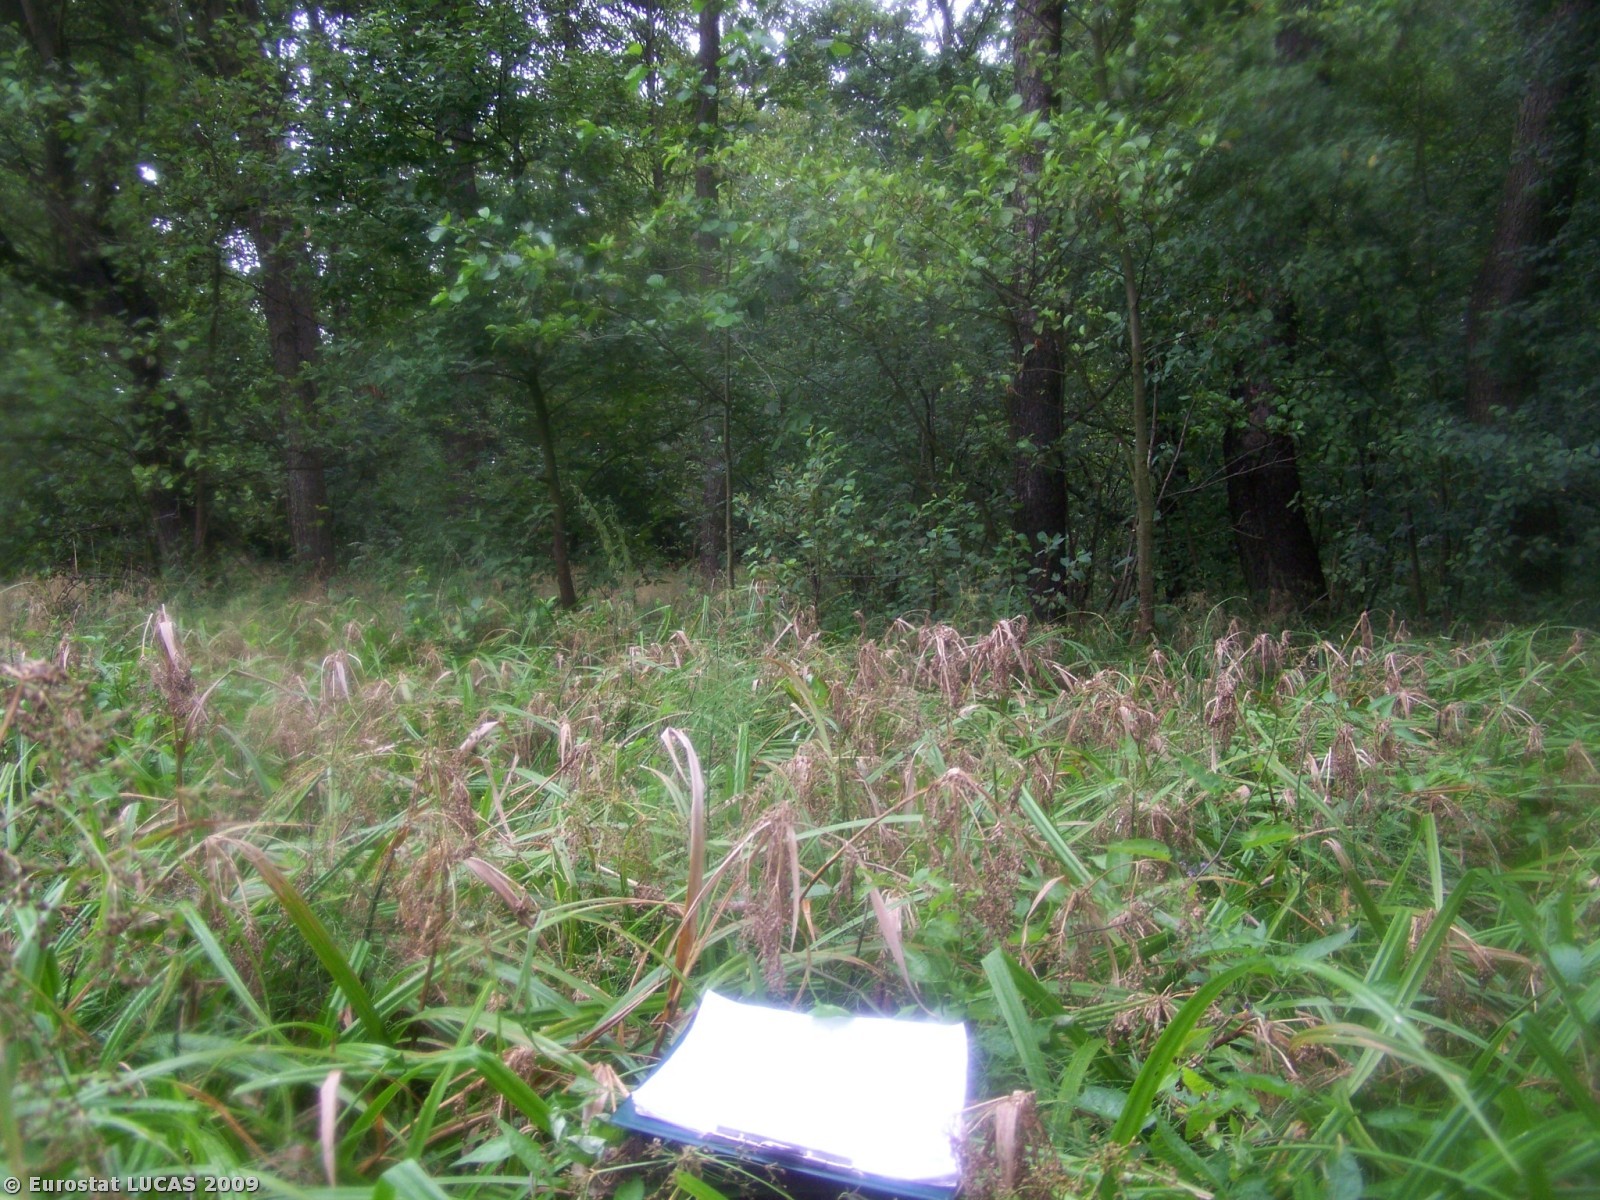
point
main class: Grassland
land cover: Spontaneously vegetated surfaces
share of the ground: > 75 %
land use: Forestry
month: July
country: PL
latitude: 51.5583
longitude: 22.0748
